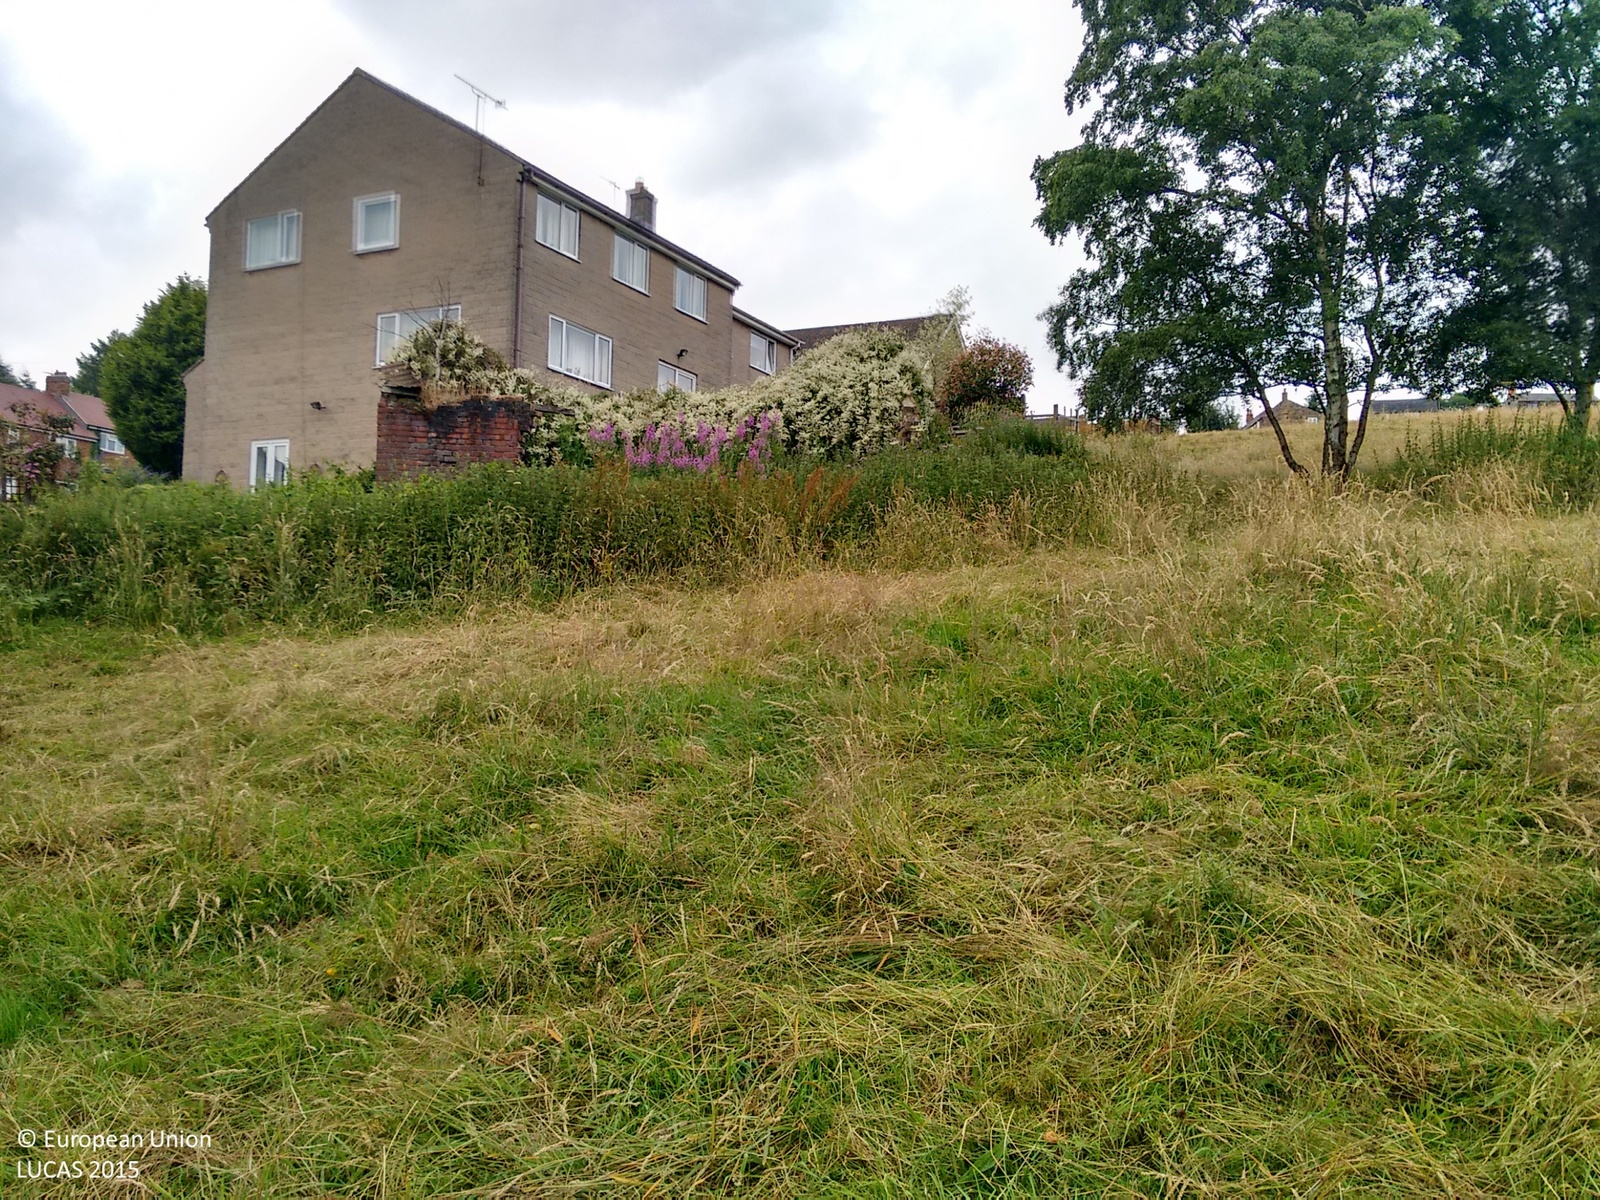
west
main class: Grassland
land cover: Grassland without tree/shrub cover
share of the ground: > 75 %
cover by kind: herbaceous plants 100 %
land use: Agriculture (excluding fallow land and kitchen gardens)
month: July
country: GB
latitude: 53.0730
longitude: -1.4683
